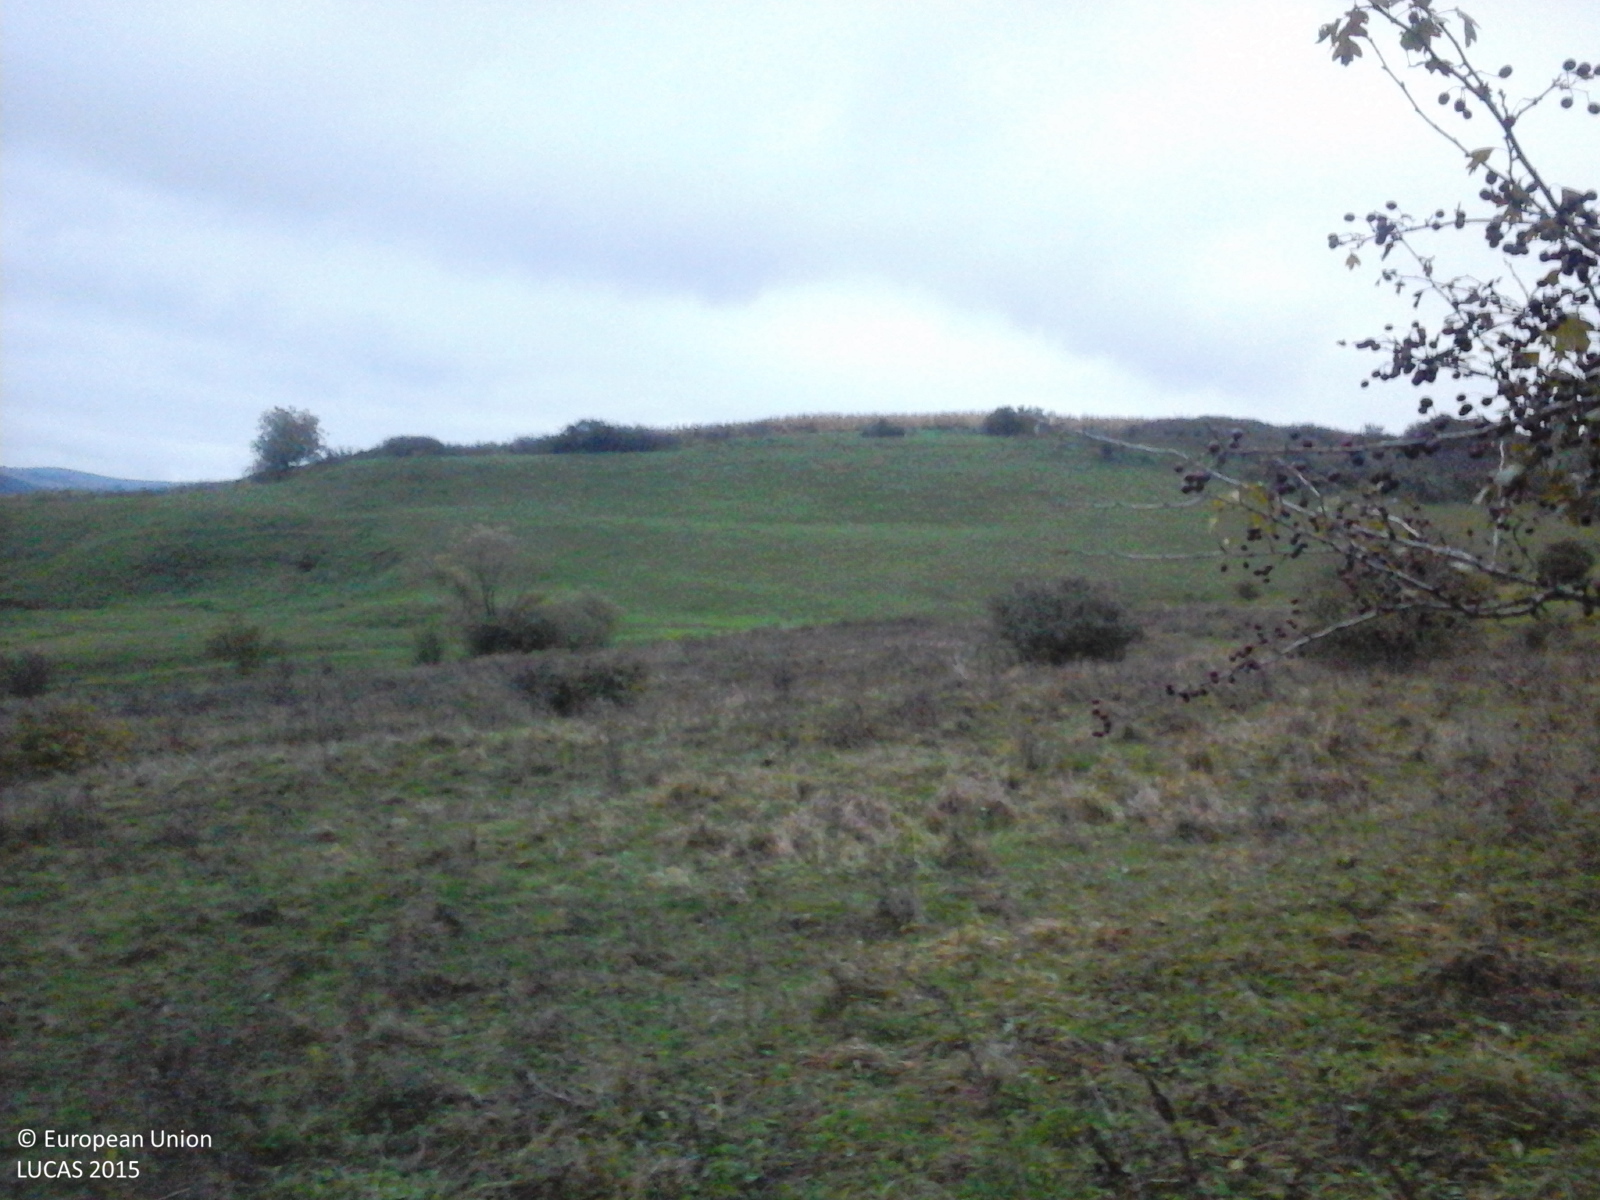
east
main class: Grassland
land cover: Grassland with sparse tree/shrub cover
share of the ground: > 75 %
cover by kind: herbaceous plants 85 %, shrubs 10 %, broadleaved forest trees 5 %
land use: Agriculture (excluding fallow land and kitchen gardens)
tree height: > 5 m
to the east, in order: Grassland with sparse tree/shrub cover; Spontaneously vegetated surfaces; Tracks; Grassland without tree/shrub cover; Maize
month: October
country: RO
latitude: 45.9175
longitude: 24.1422
